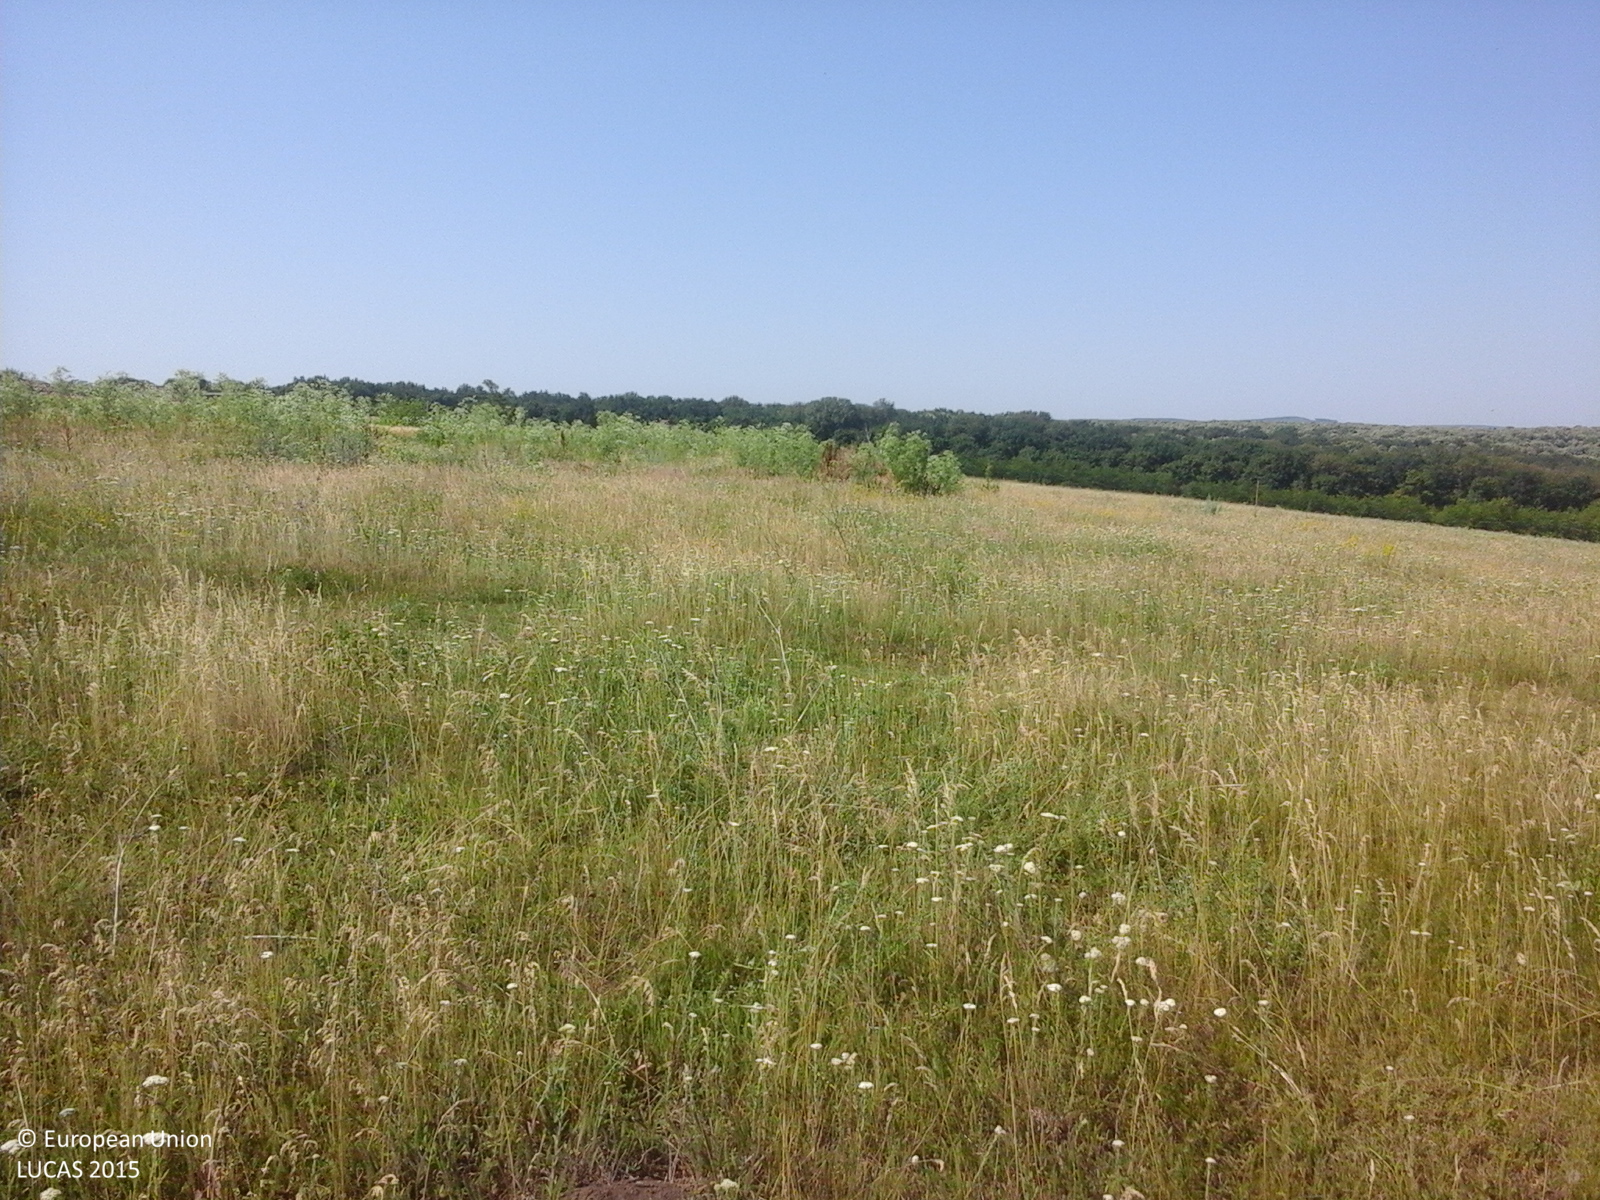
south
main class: Grassland
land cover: Grassland without tree/shrub cover
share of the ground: > 75 %
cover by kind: herbaceous plants 100 %
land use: Agriculture (excluding fallow land and kitchen gardens)
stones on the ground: < 10 %
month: June
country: RO
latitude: 47.1000
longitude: 27.5211
